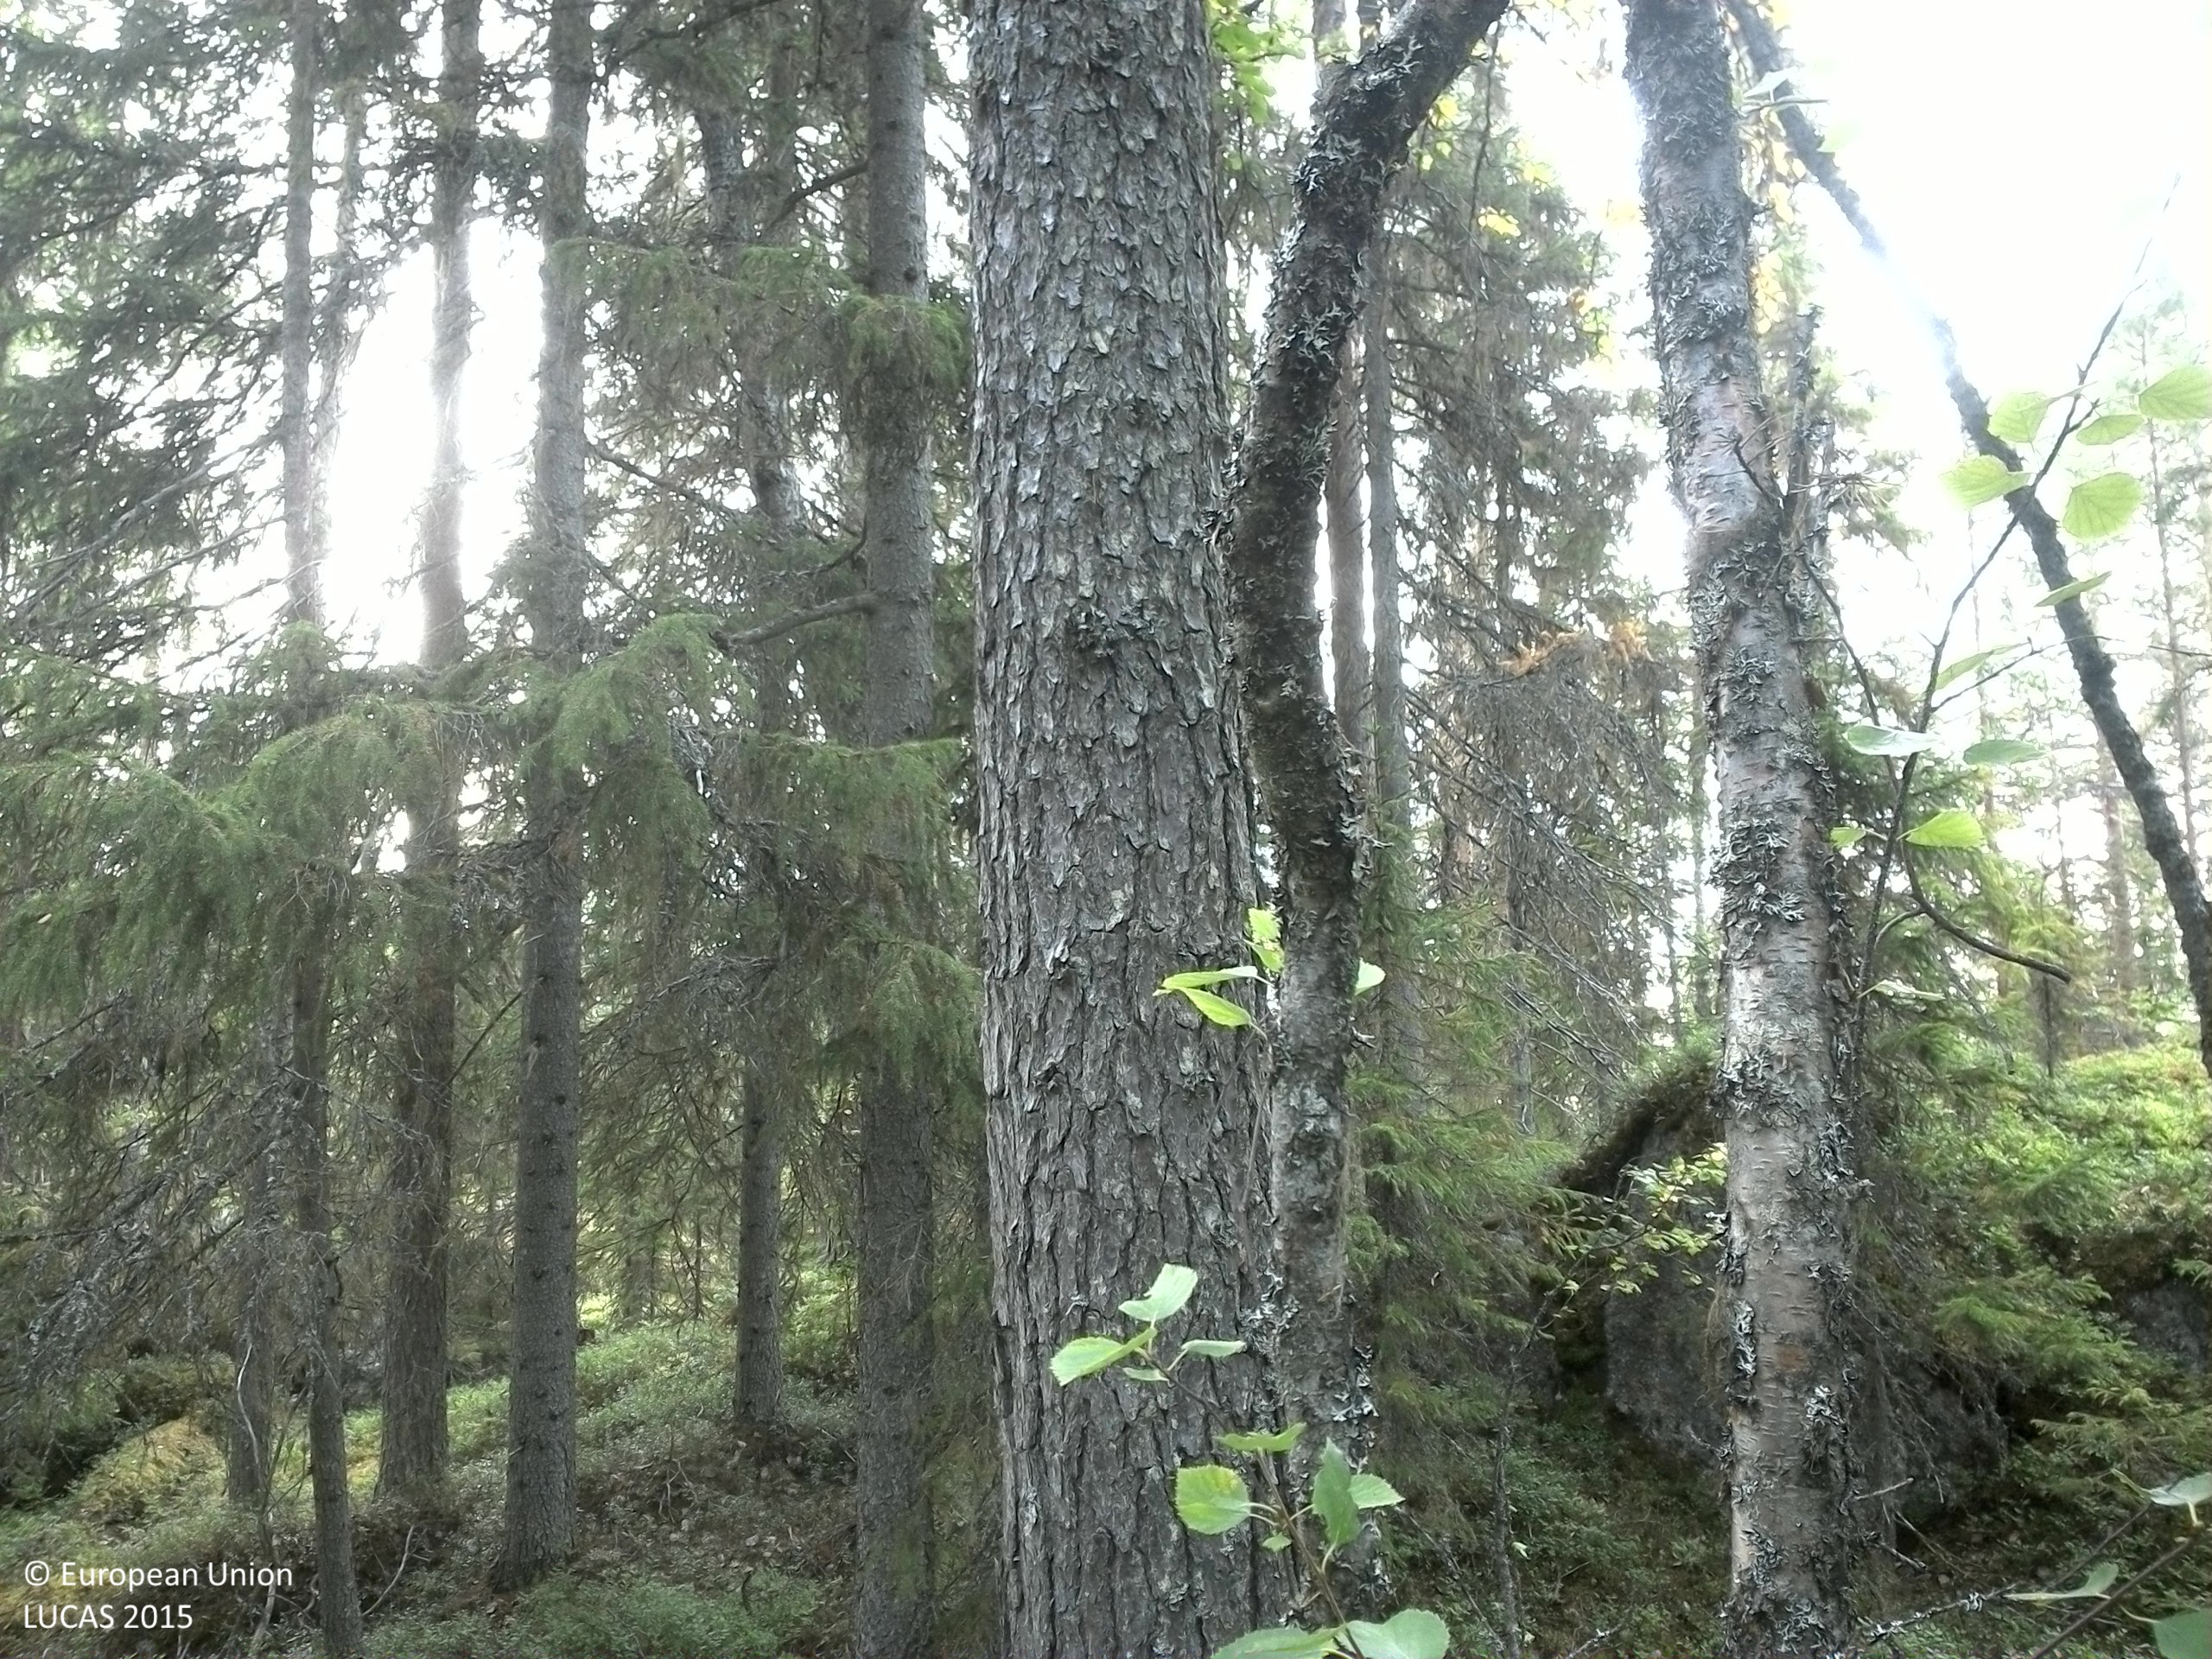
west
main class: Woodland
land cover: Pine dominated coniferous woodland
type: boreal forest
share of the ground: > 75 %
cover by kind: coniferous forest trees 70 %, shrubs 20 %, broadleaved forest trees 10 %
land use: Forestry
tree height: > 5 m
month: September
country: SE
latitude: 63.9944
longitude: 17.6774
